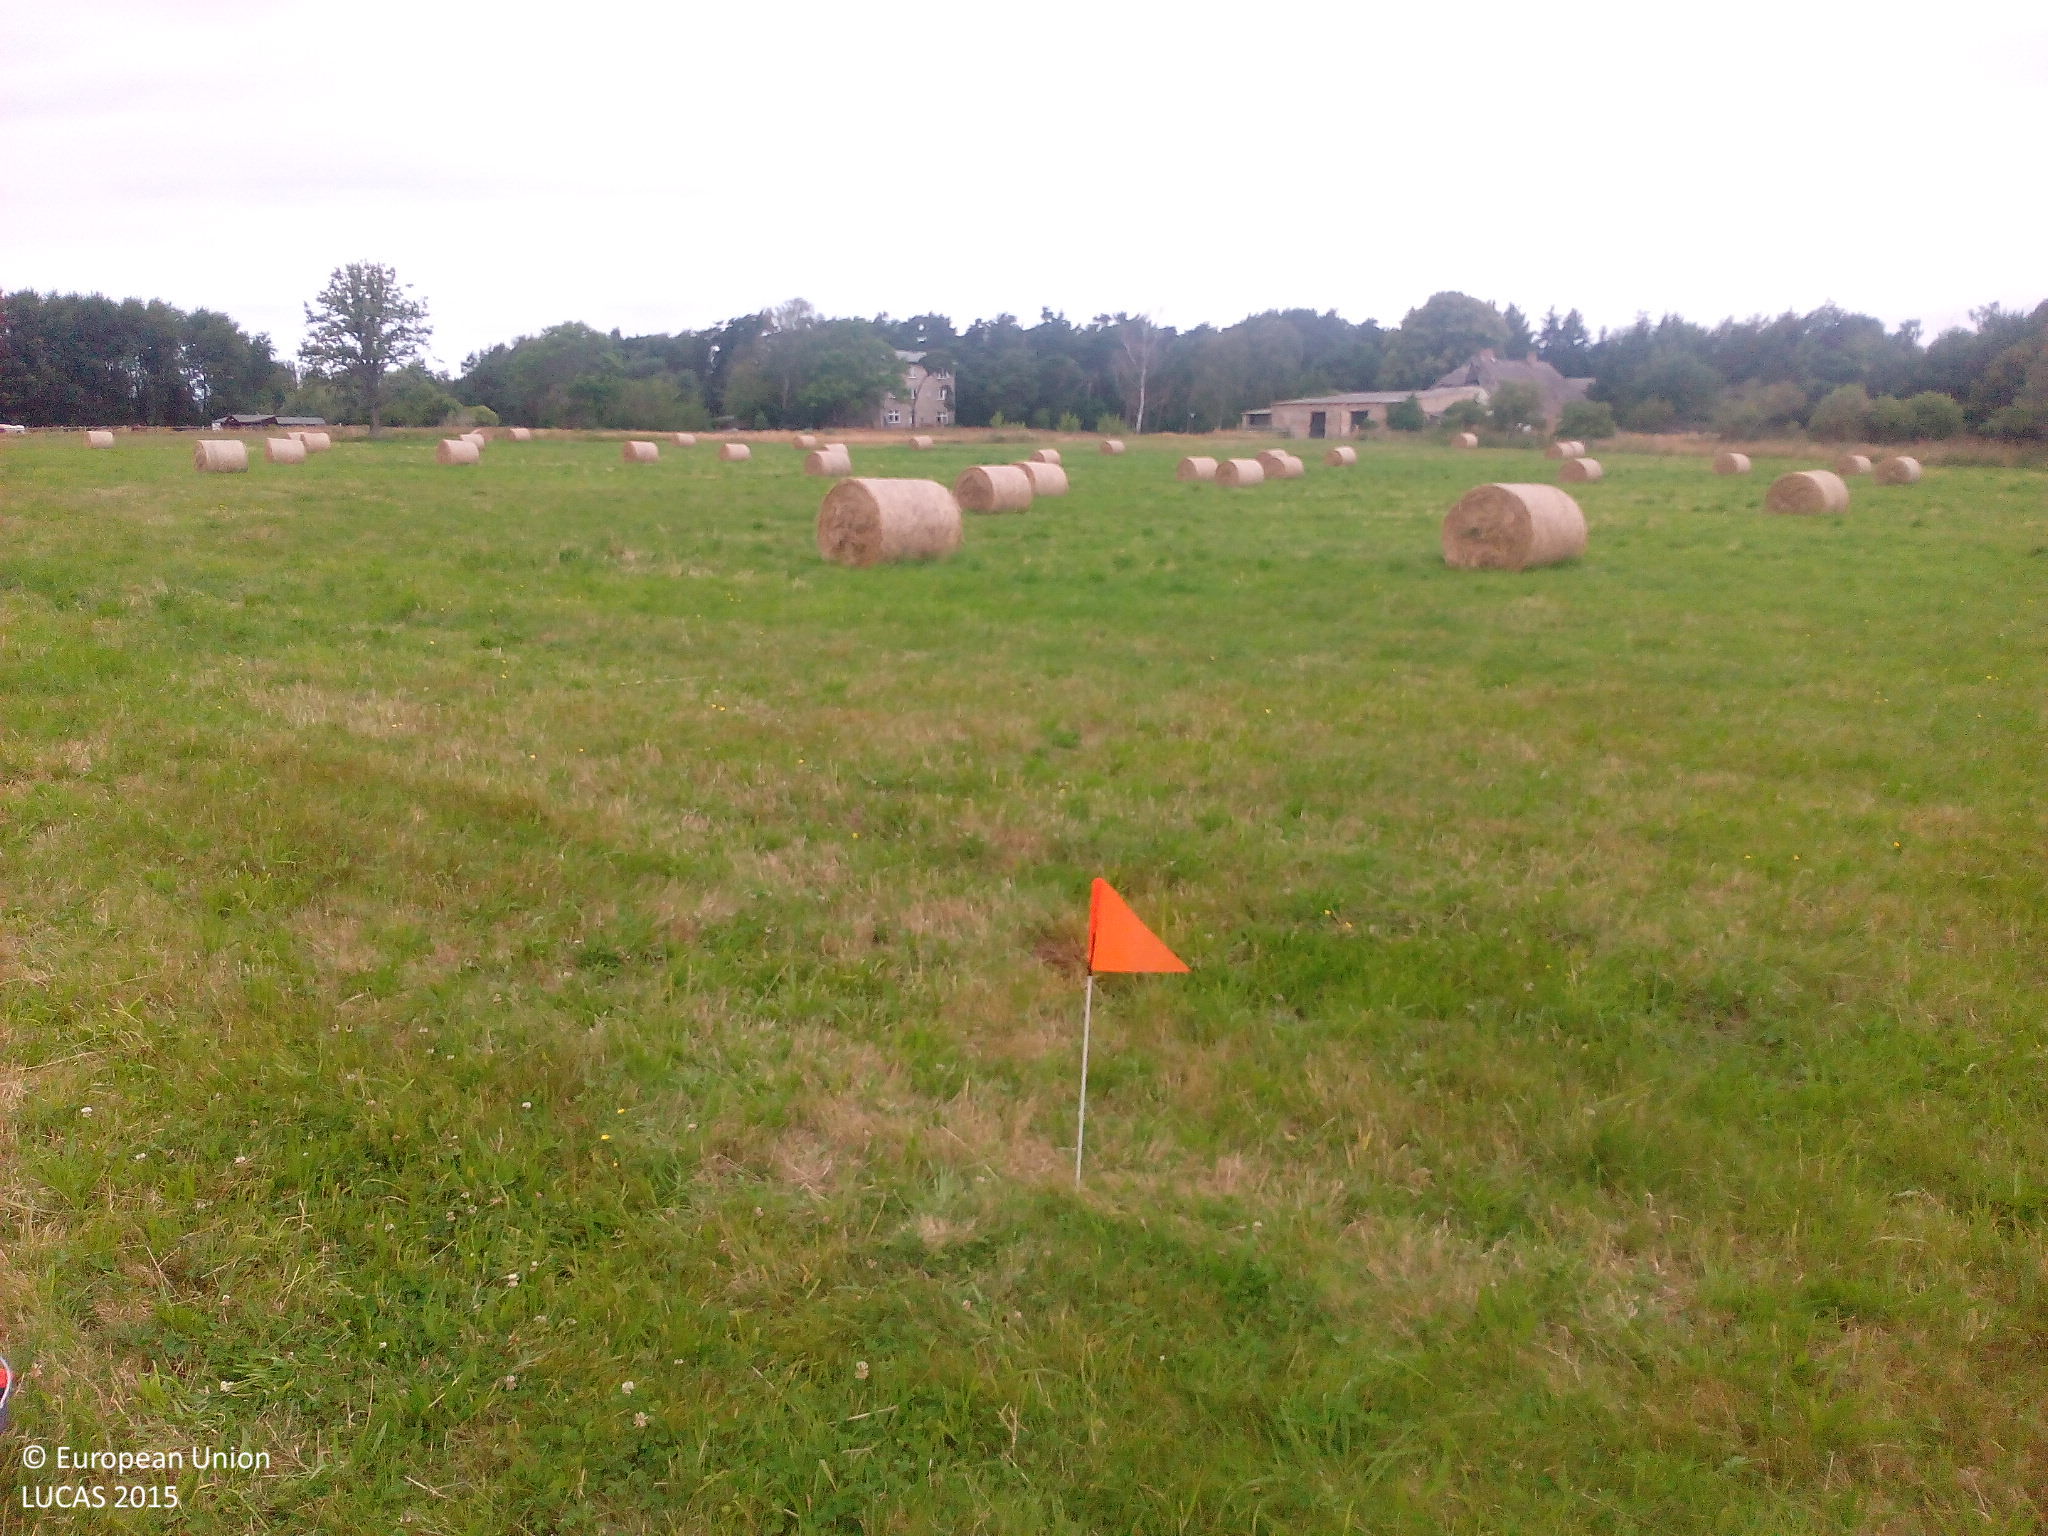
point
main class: Grassland
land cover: Grassland without tree/shrub cover
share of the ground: > 75 %
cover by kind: herbaceous plants 100 %
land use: Agriculture (excluding fallow land and kitchen gardens)
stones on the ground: < 10 %
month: July
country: DE
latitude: 54.2788
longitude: 12.3181
